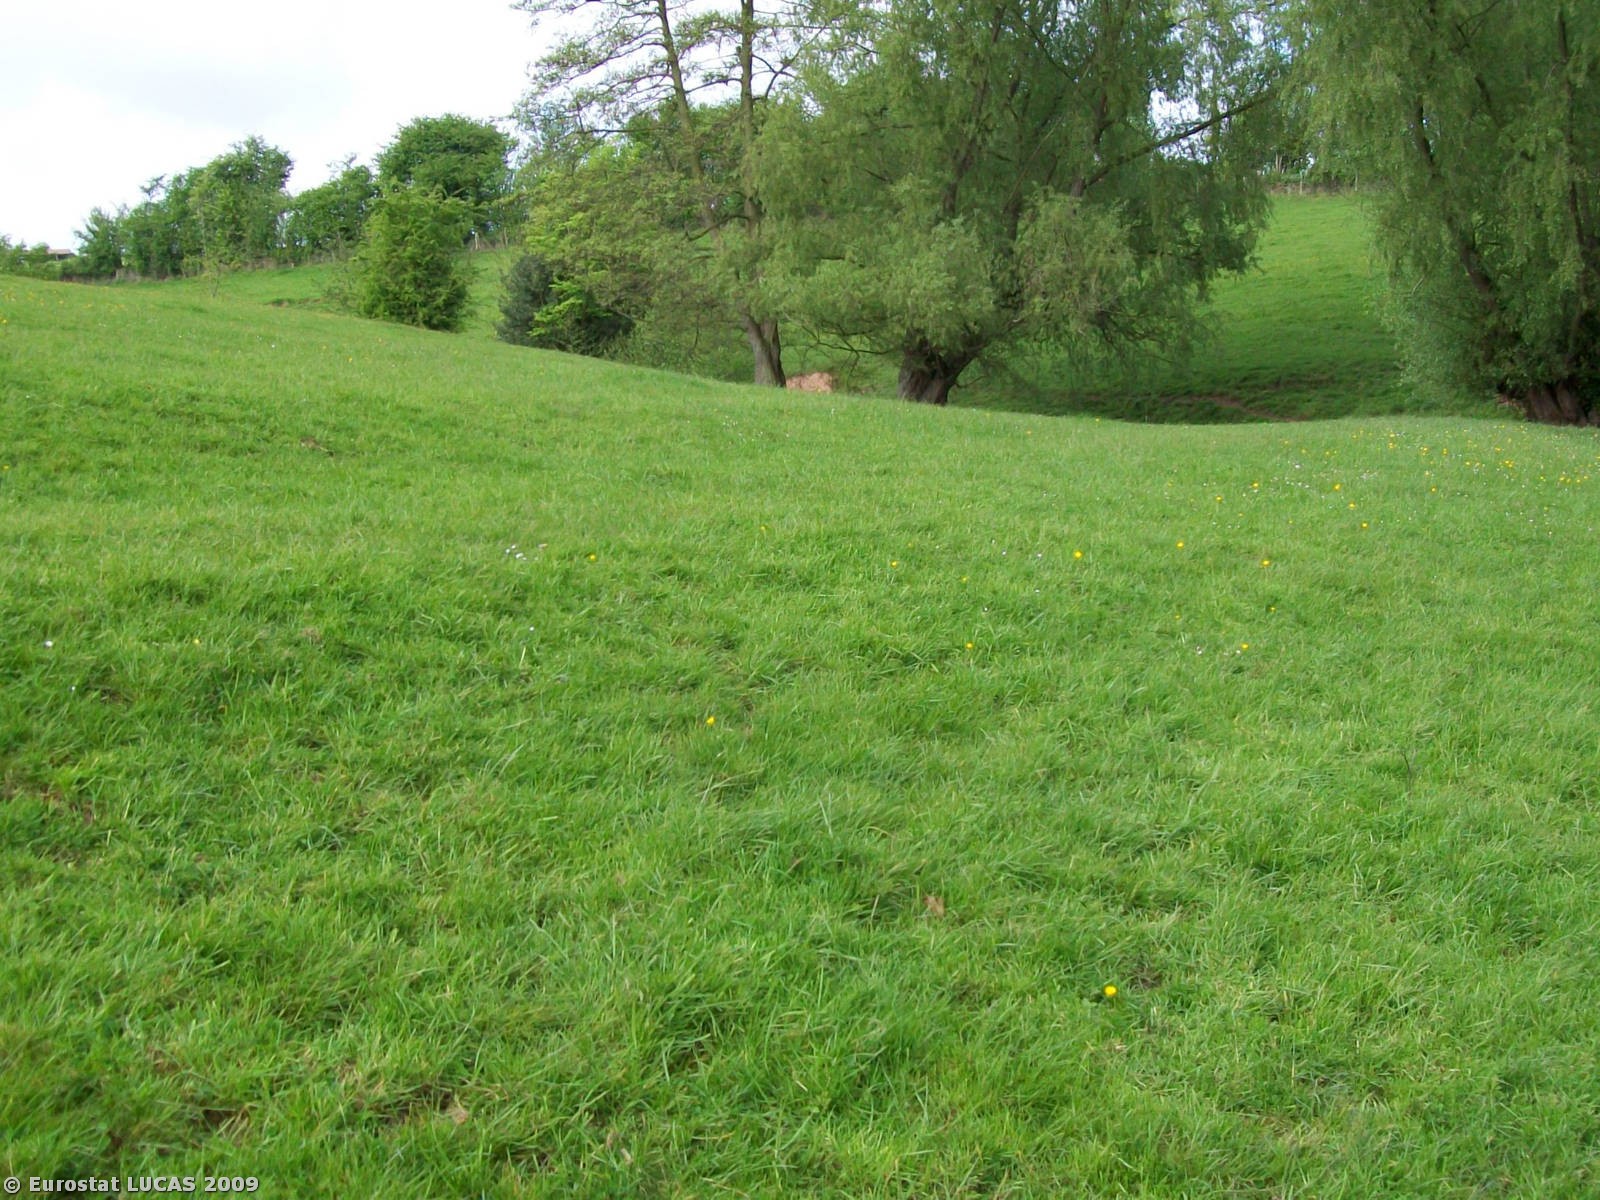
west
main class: Grassland
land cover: Grassland without tree/shrub cover
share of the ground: > 75 %
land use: Agriculture (excluding fallow land and kitchen gardens)
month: May
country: GB
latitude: 52.2974
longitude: -2.4860
